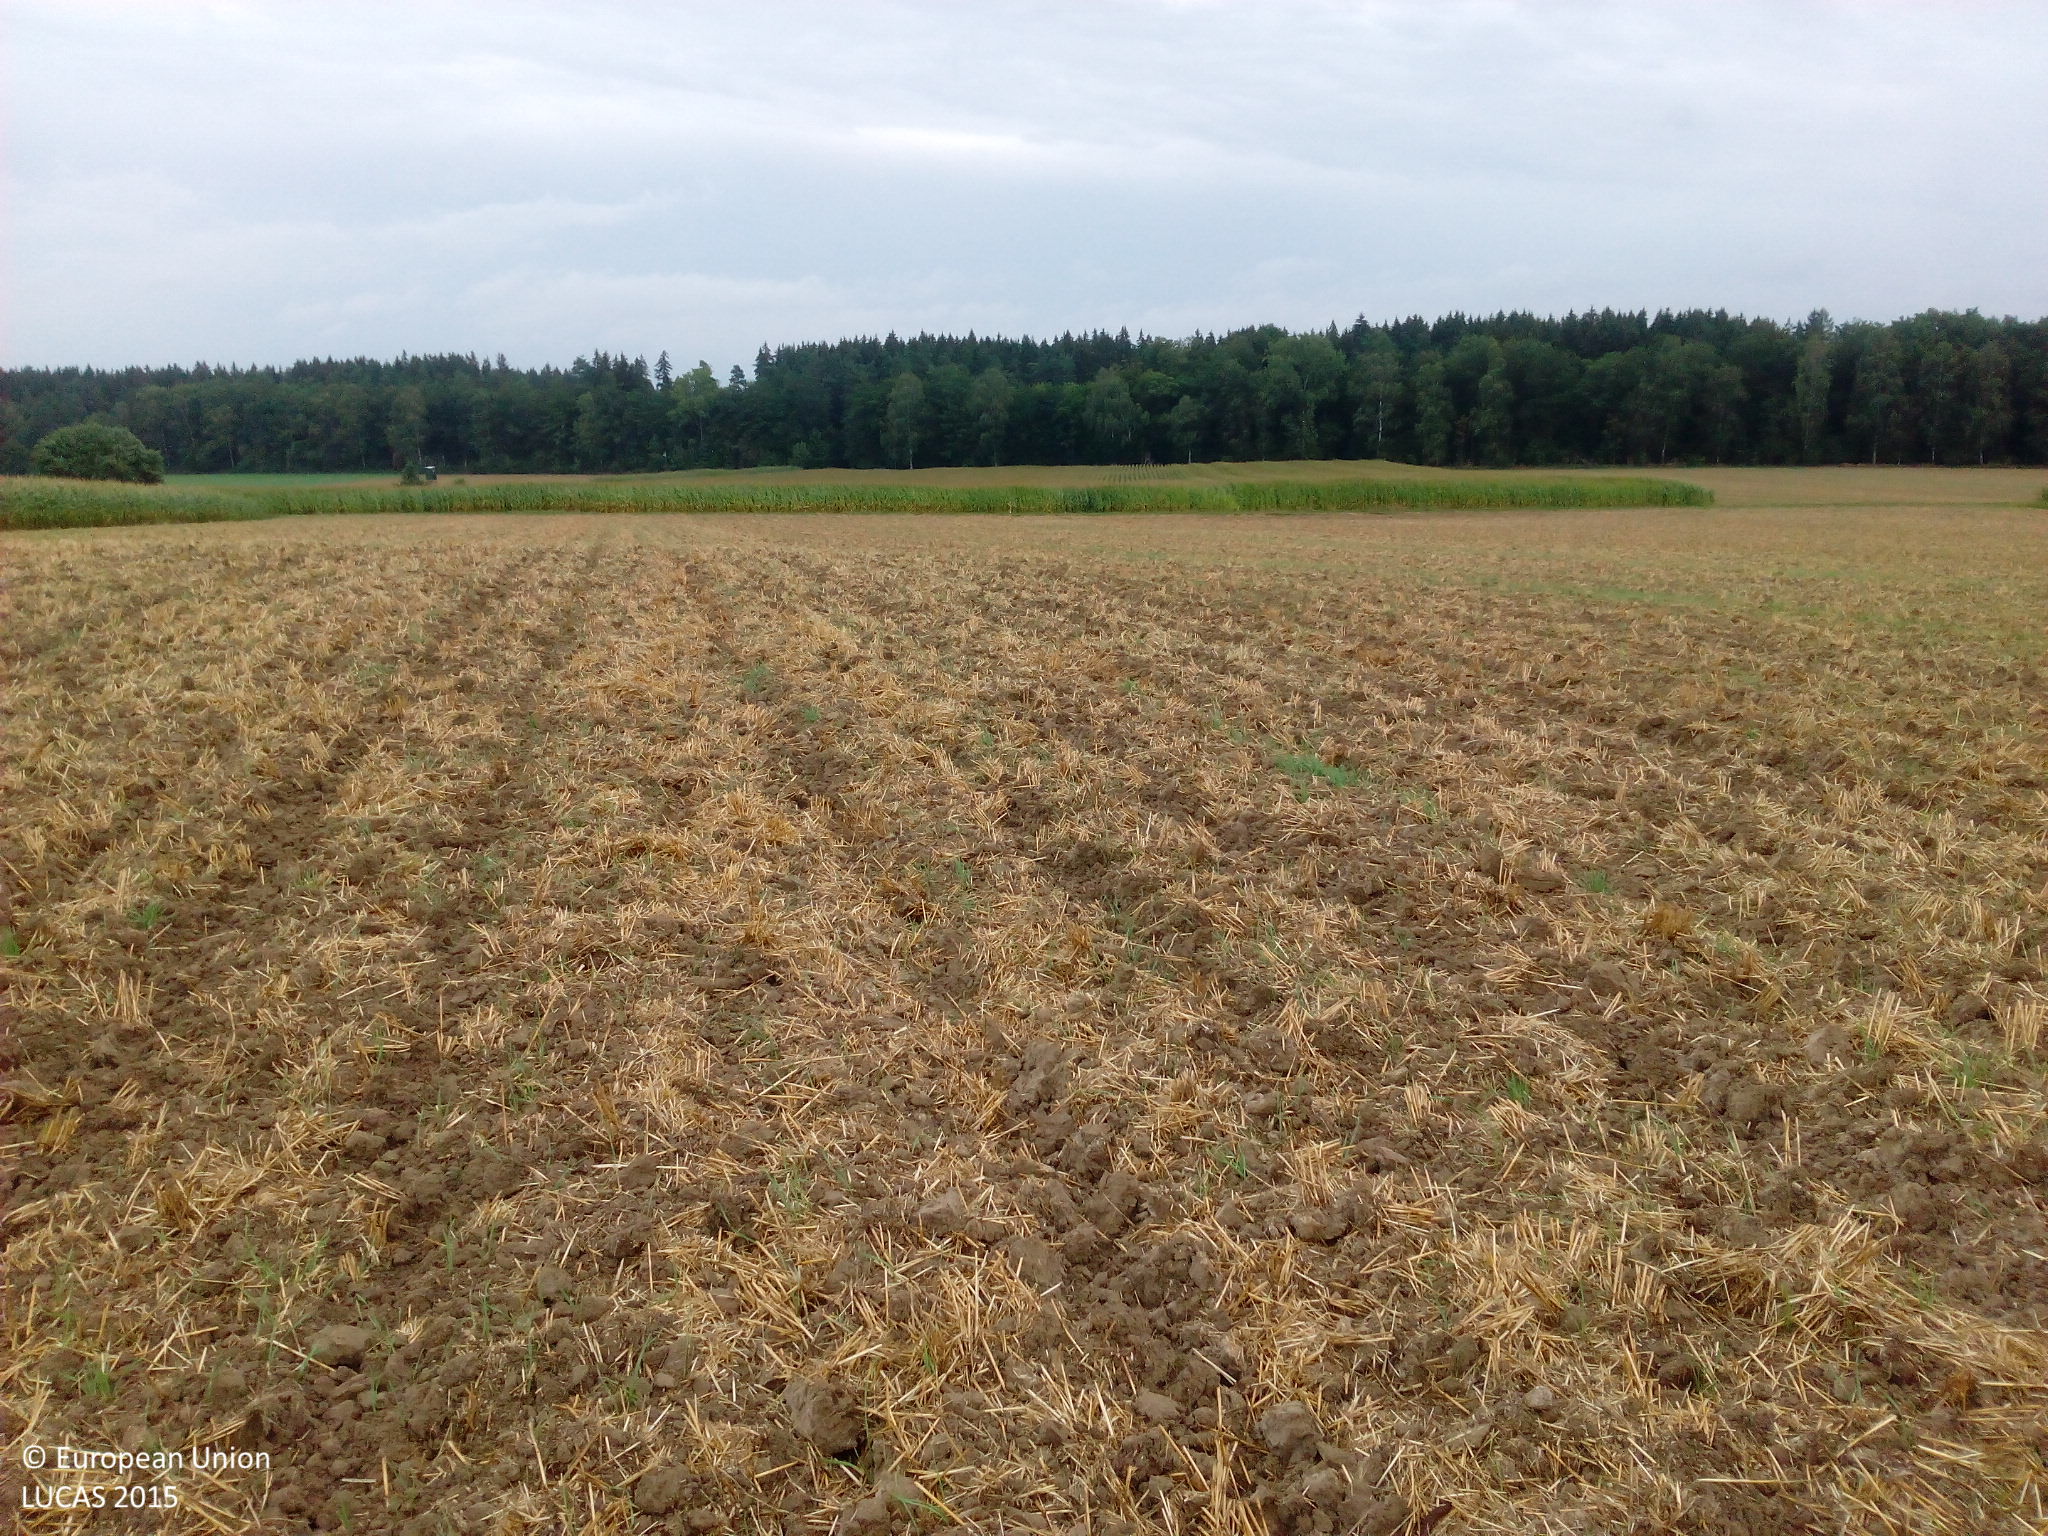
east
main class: Cropland
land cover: Common wheat
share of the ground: < 10 %
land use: Agriculture (excluding fallow land and kitchen gardens)
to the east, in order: Common wheat; Grass margins; Tracks; Grass margins; Maize
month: September
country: DE
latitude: 48.2952
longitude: 10.2560
